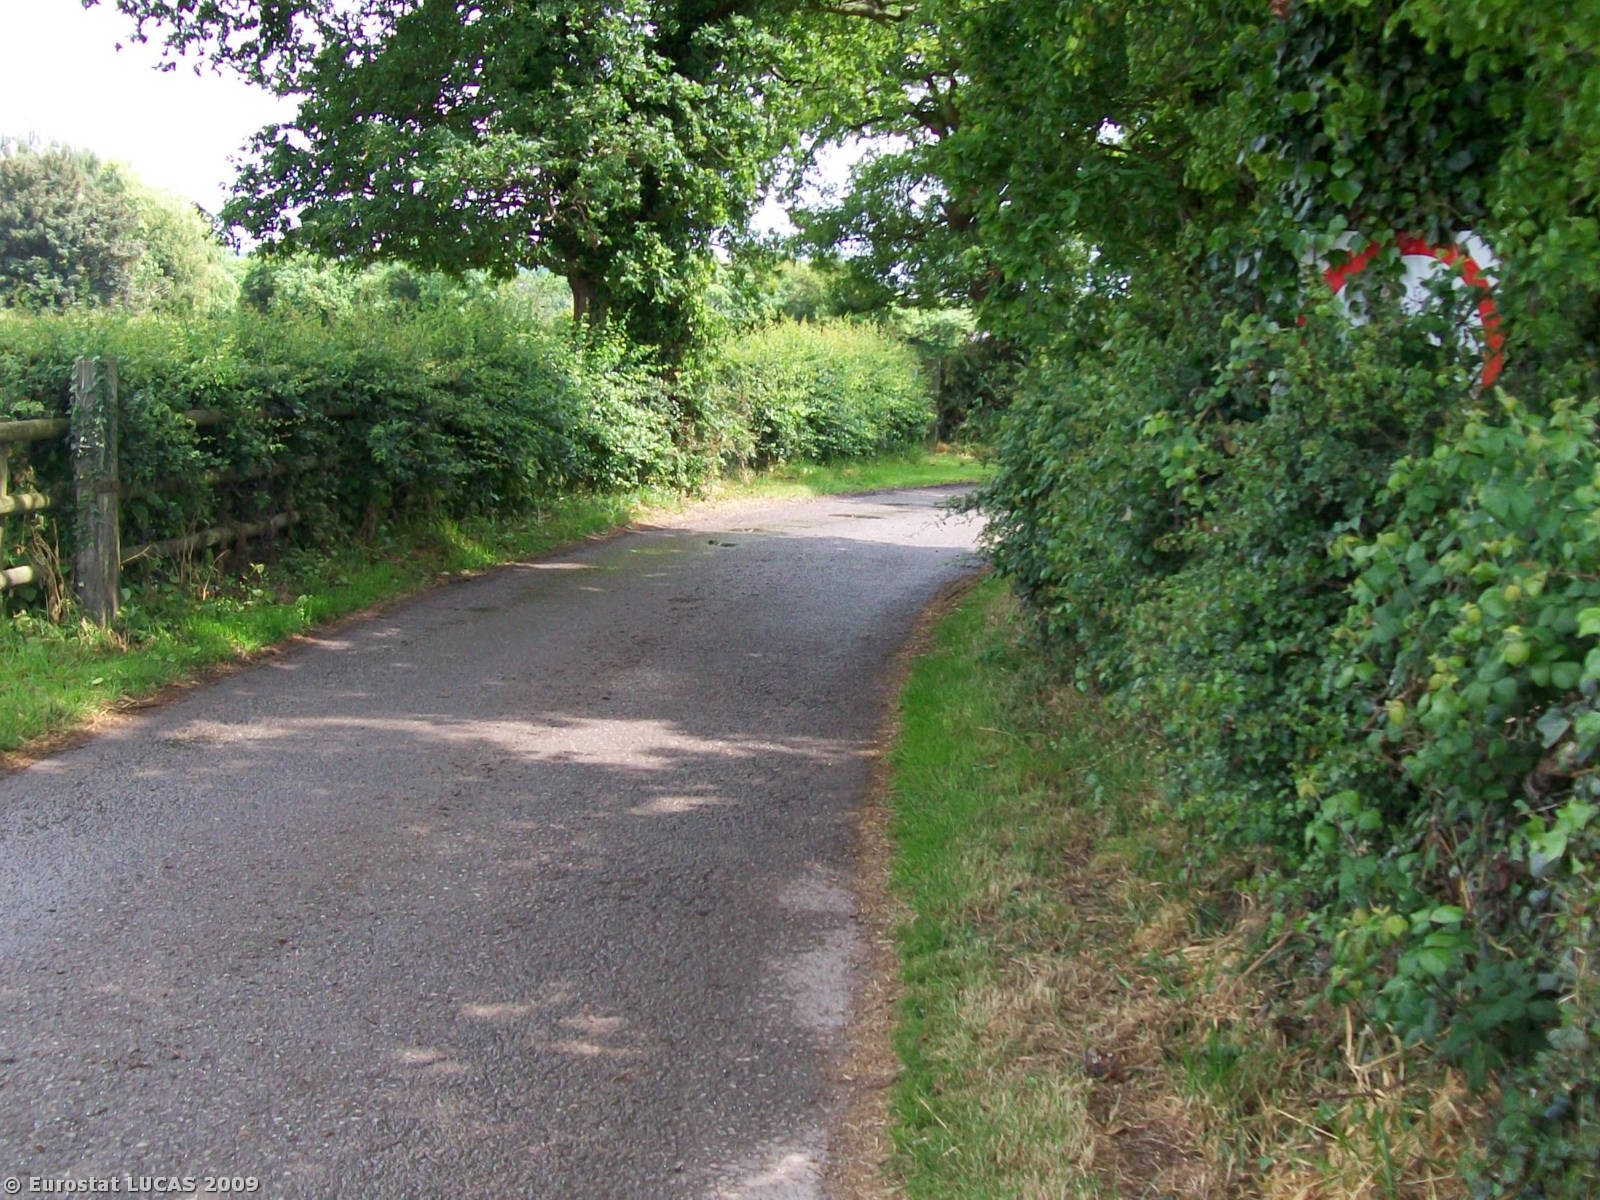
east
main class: Grassland
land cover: Grassland without tree/shrub cover
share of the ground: > 75 %
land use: Agriculture (excluding fallow land and kitchen gardens)
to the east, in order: Grassland without tree/shrub cover; Tracks; Fences; Grassland without tree/shrub cover
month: June
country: GB
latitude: 53.1659
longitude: -2.7089
